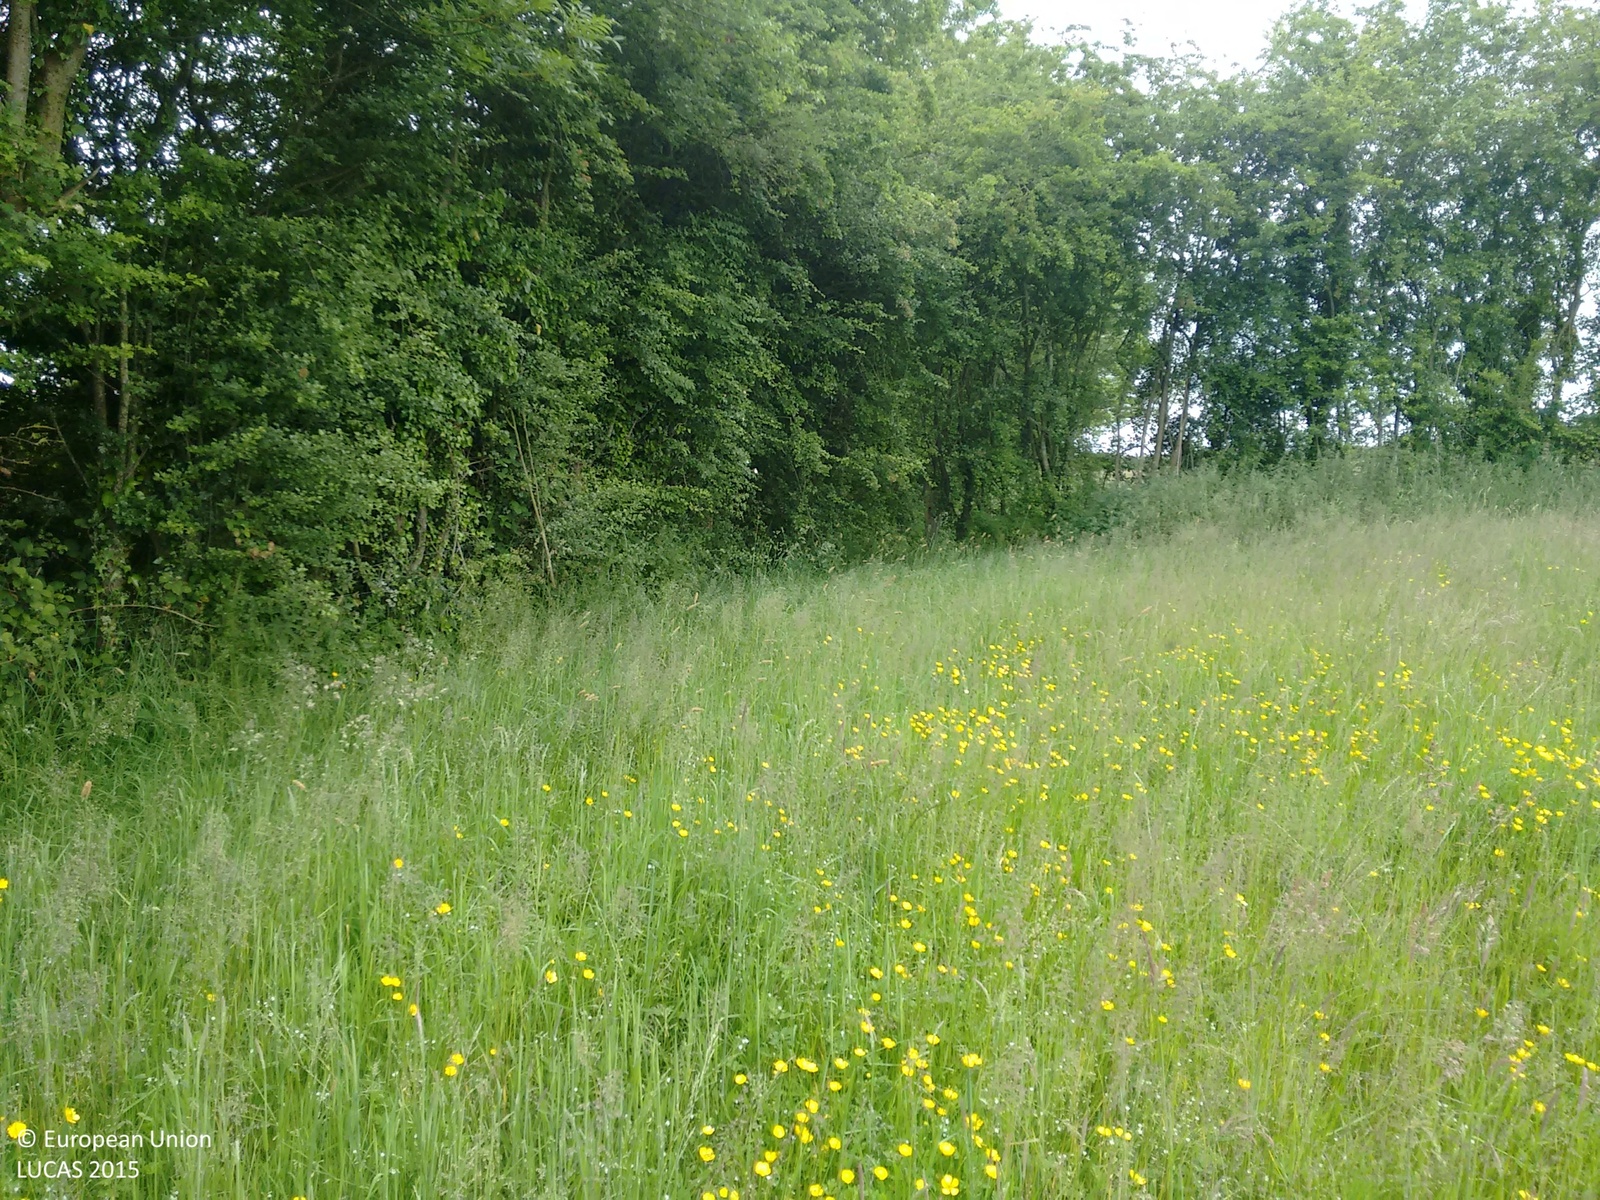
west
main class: Grassland
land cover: Grassland without tree/shrub cover
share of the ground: > 75 %
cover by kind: herbaceous plants 100 %
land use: Agriculture (excluding fallow land and kitchen gardens)
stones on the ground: < 10 %
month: June
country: IE
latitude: 53.6208
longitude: -6.7491
